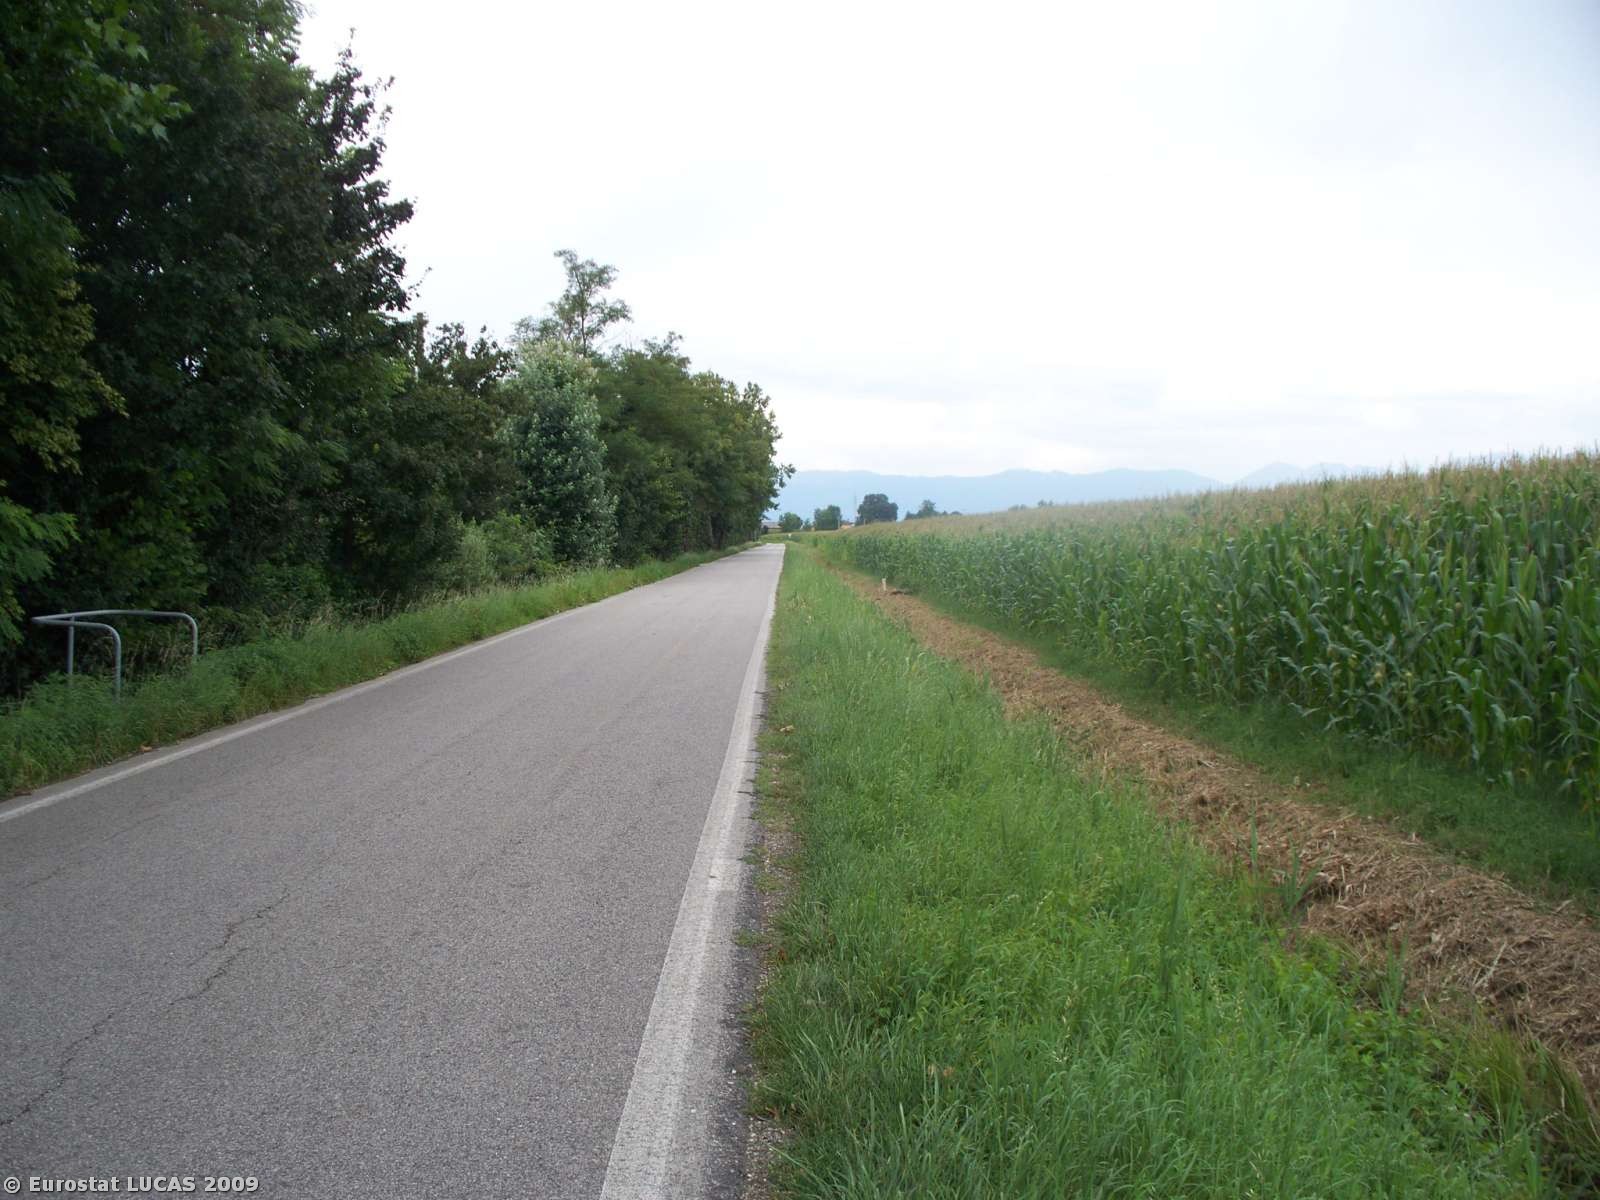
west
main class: Cropland
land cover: Maize
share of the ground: > 75 %
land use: Agriculture (excluding fallow land and kitchen gardens)
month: July
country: IT
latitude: 45.8190
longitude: 12.4292
